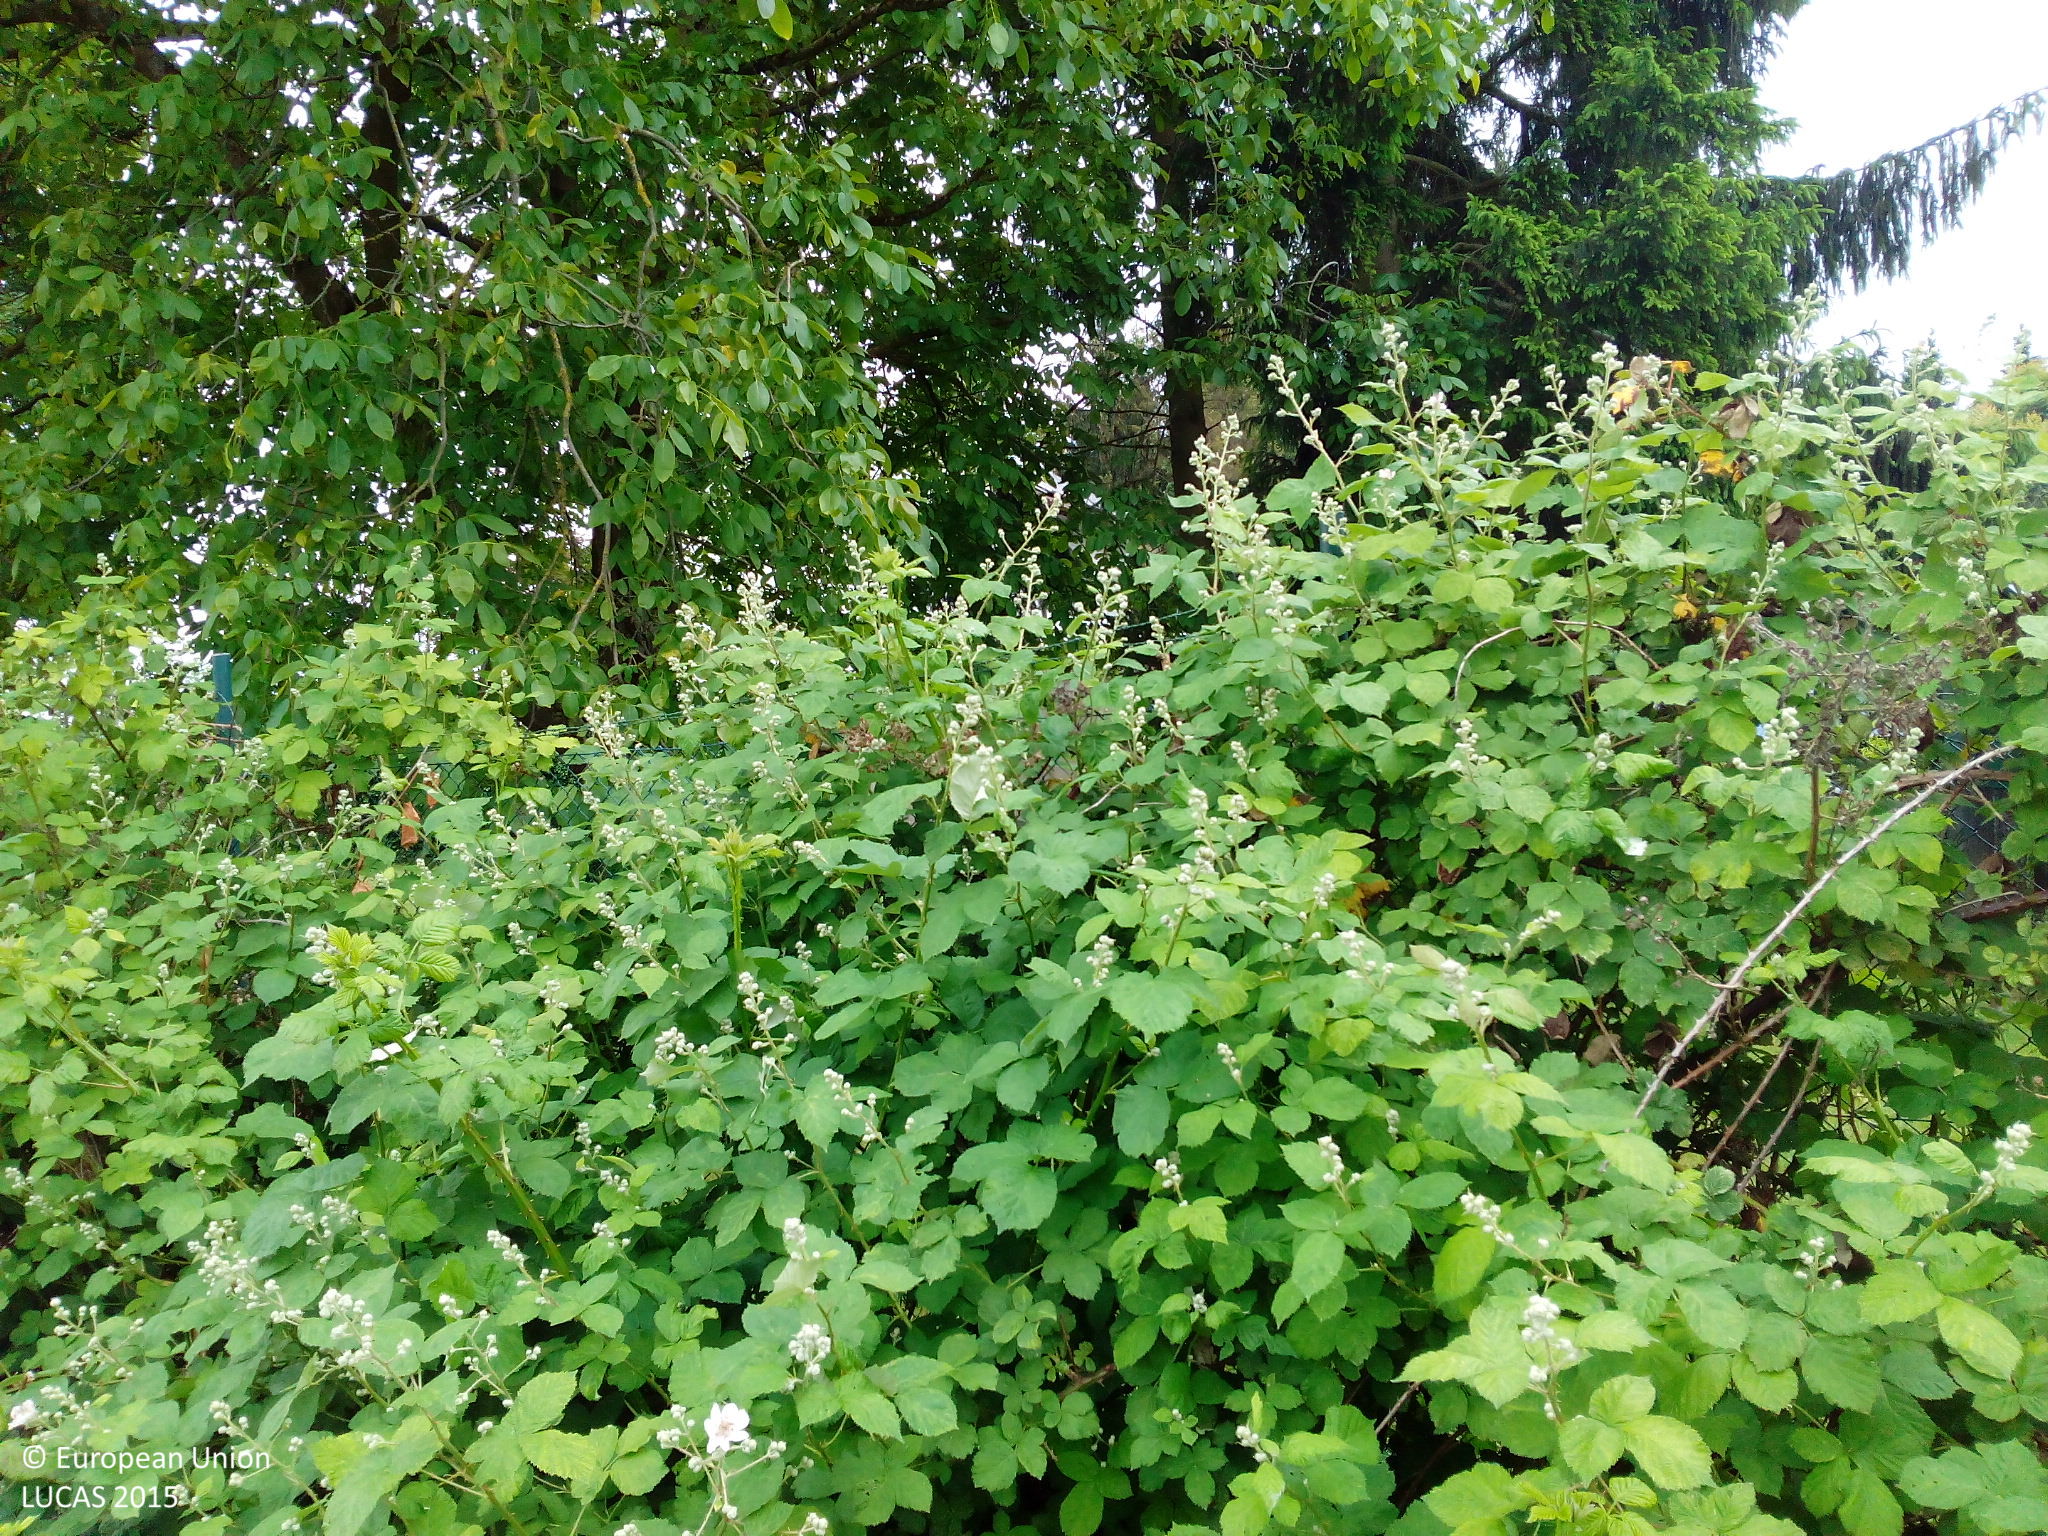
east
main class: Cropland
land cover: Other cereals
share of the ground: 10 - 25 %
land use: Agriculture (excluding fallow land and kitchen gardens)
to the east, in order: Other cereals; Paved roads, cycling and walking lanes; Apple fruit; Grass margins; Paved roads, cycling and walking lanes; Grass margins; Paved roads, cycling and walking lanes; Grassland without tree/shrub cover; Shrubland without tree cover; Maize; Grassland without tree/shrub cover; Lines of trees
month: May
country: DE
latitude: 48.8565
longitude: 8.1879
